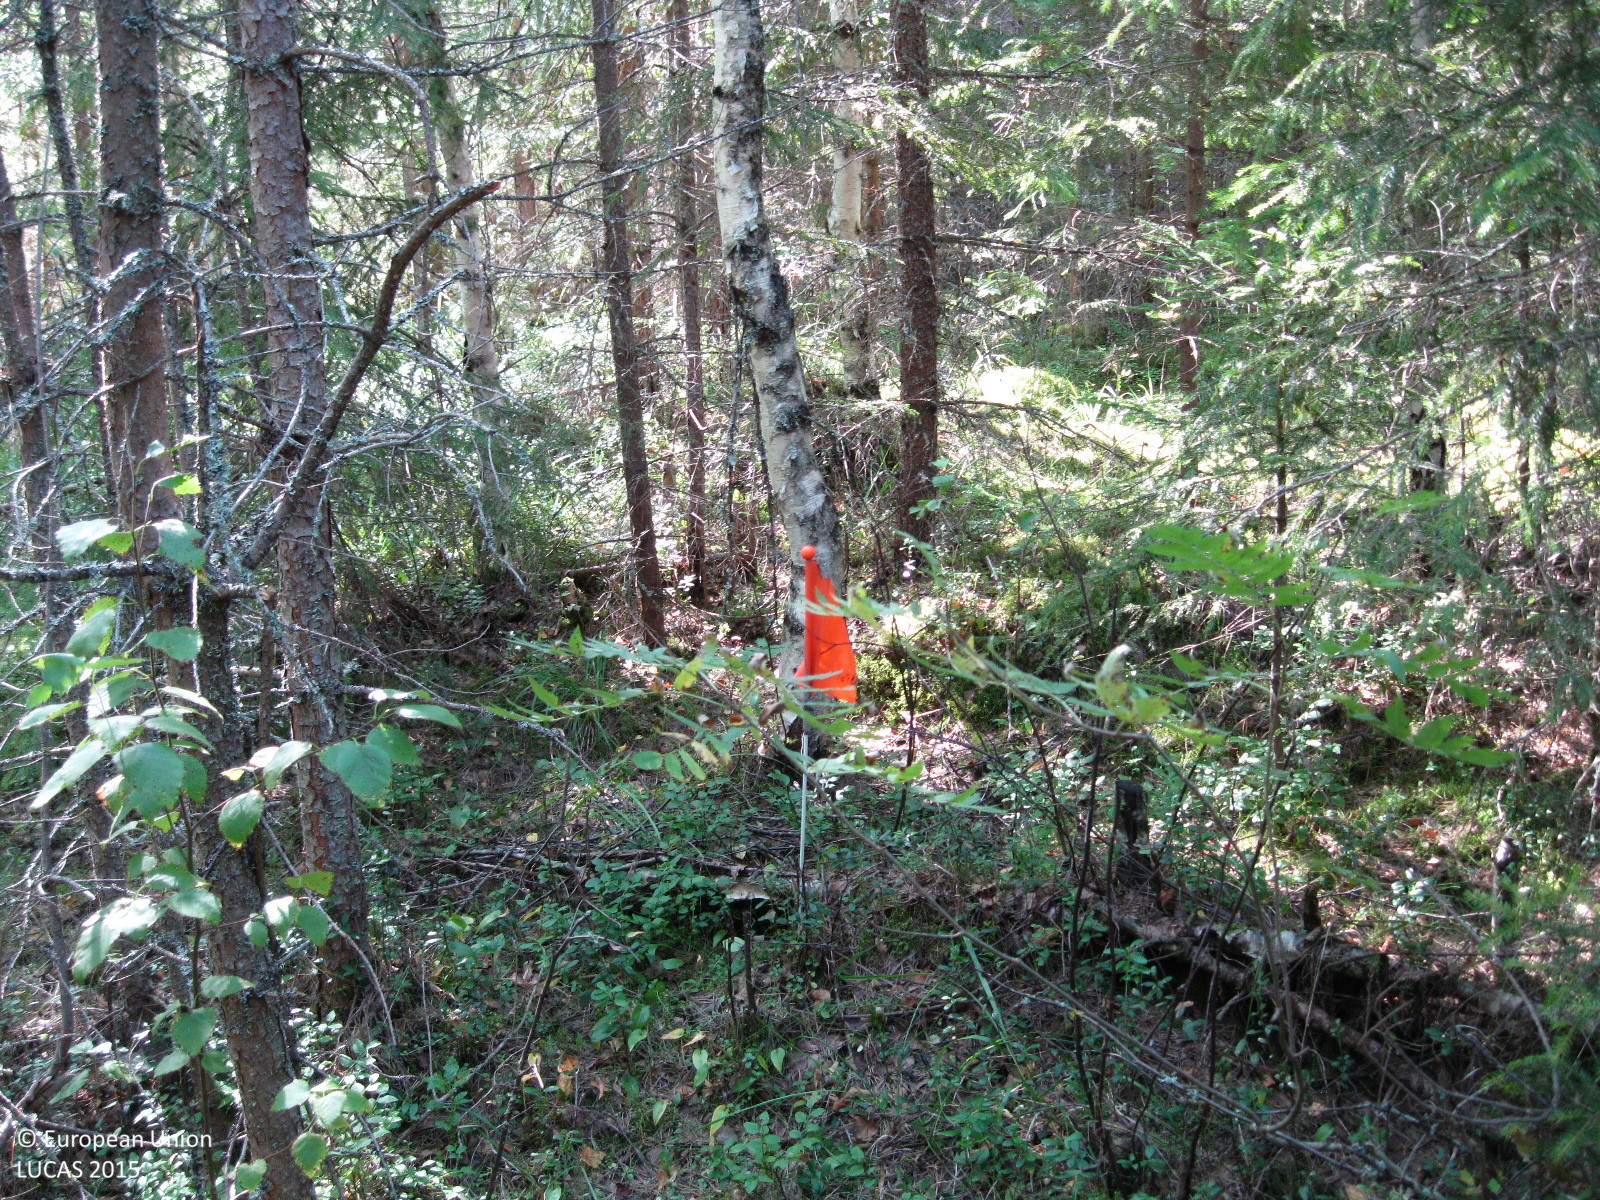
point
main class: Woodland
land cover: Other mixed woodland
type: boreal forest
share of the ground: > 75 %
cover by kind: coniferous forest trees 65 %, broadleaved forest trees 25 %, shrubs 5 %, lichens and mosses 5 %
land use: Forestry
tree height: > 5 m
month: August
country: FI
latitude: 61.4223
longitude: 25.0853
